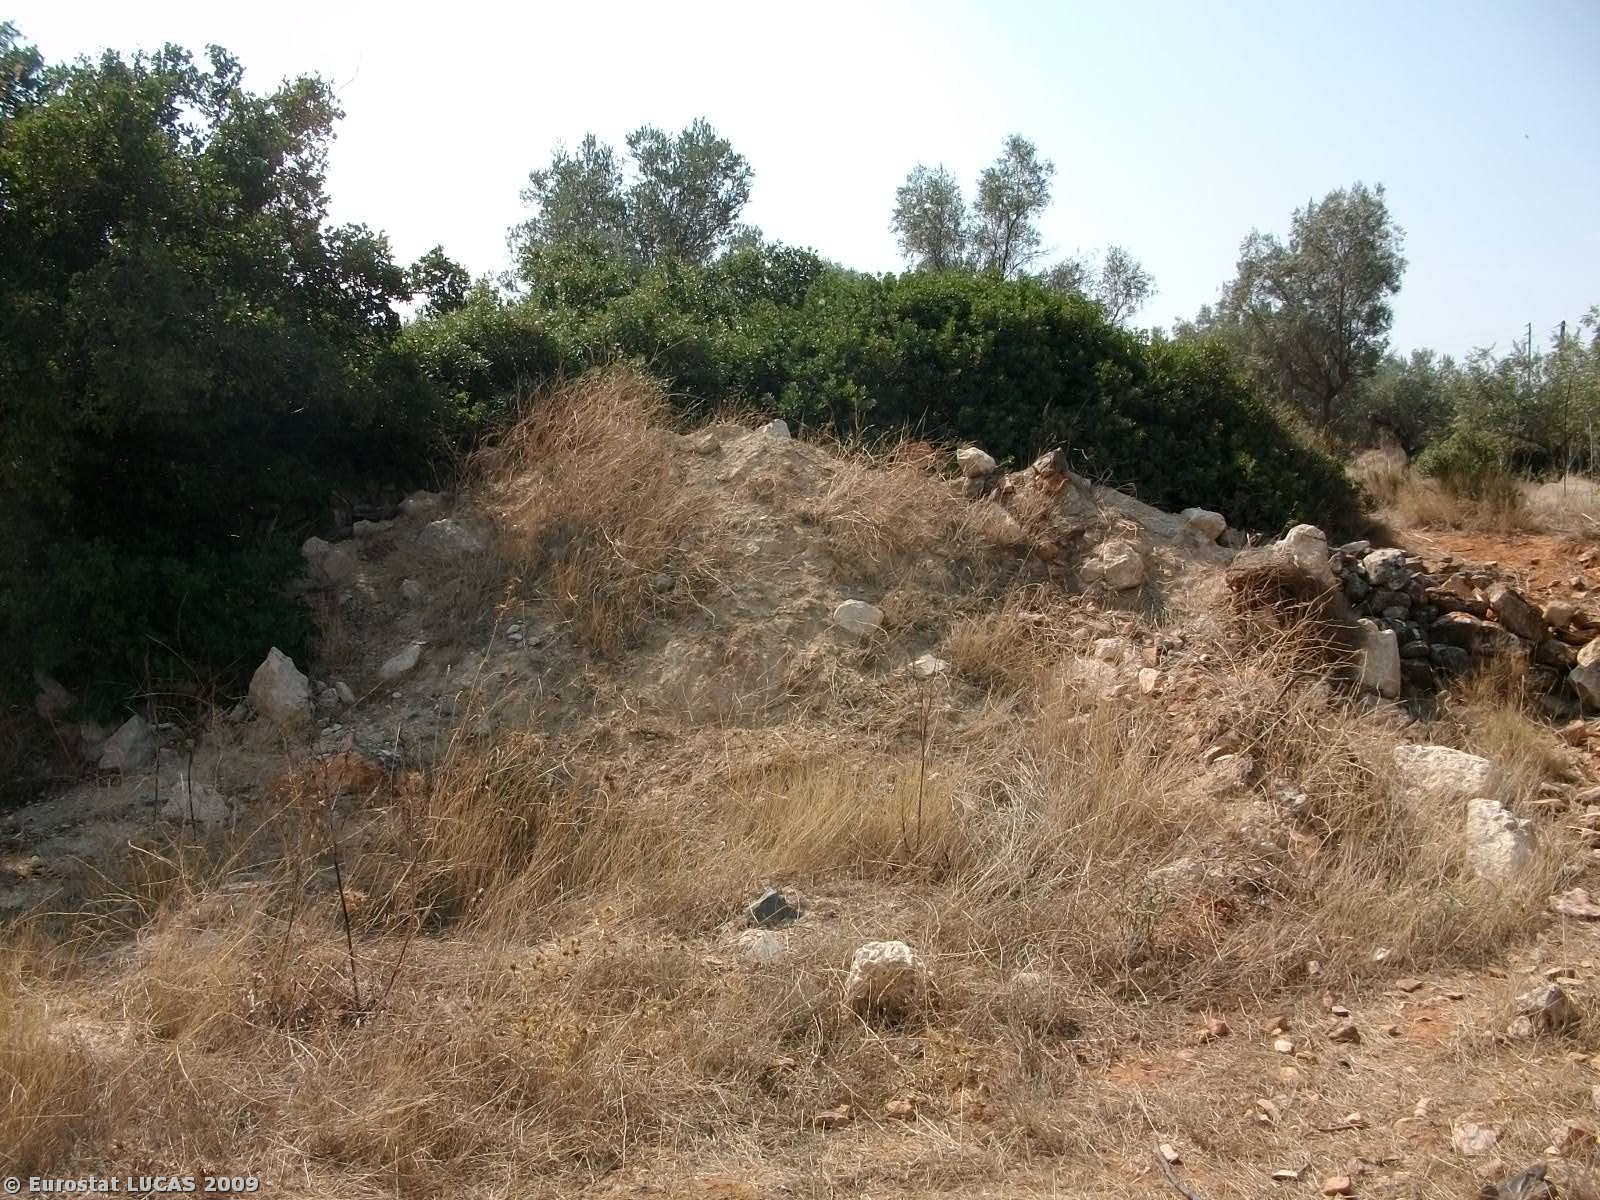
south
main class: Cropland
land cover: Olive groves
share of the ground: 10 - 25 %
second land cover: Grassland with sparse tree/shrub cover
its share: > 75 %
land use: Agriculture (excluding fallow land and kitchen gardens)
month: October
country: GR
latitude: 37.8805
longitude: 23.8855
